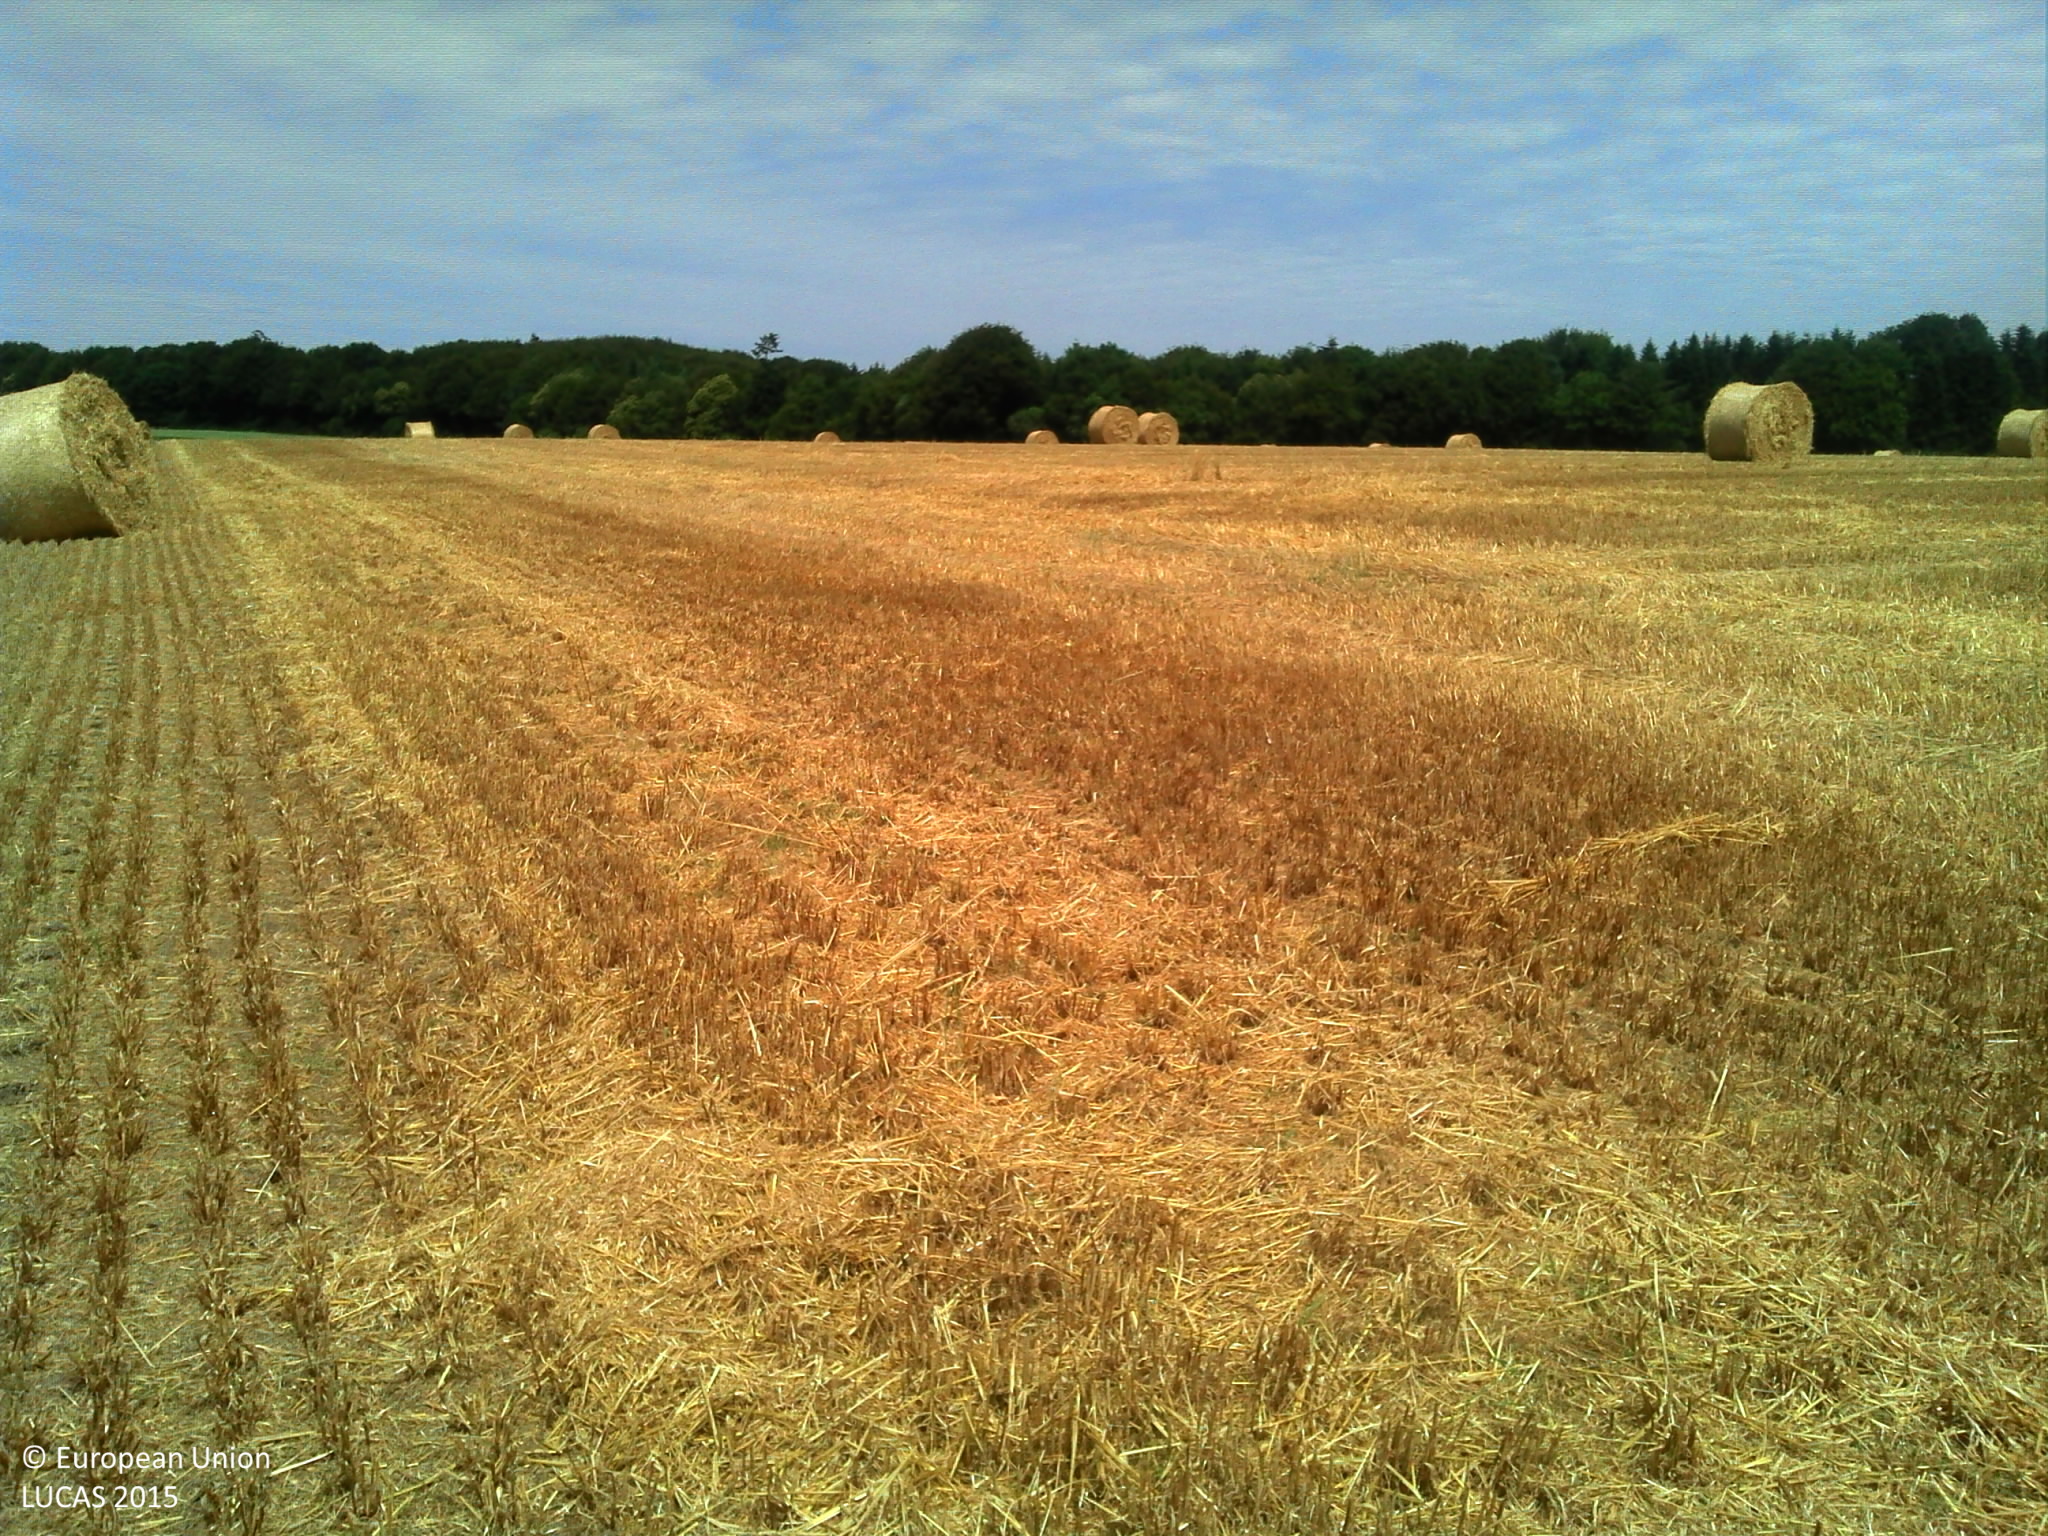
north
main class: Cropland
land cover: Barley
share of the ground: > 75 %
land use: Agriculture (excluding fallow land and kitchen gardens)
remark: Harvested field
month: July
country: FR
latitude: 47.9052
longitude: -3.3035
